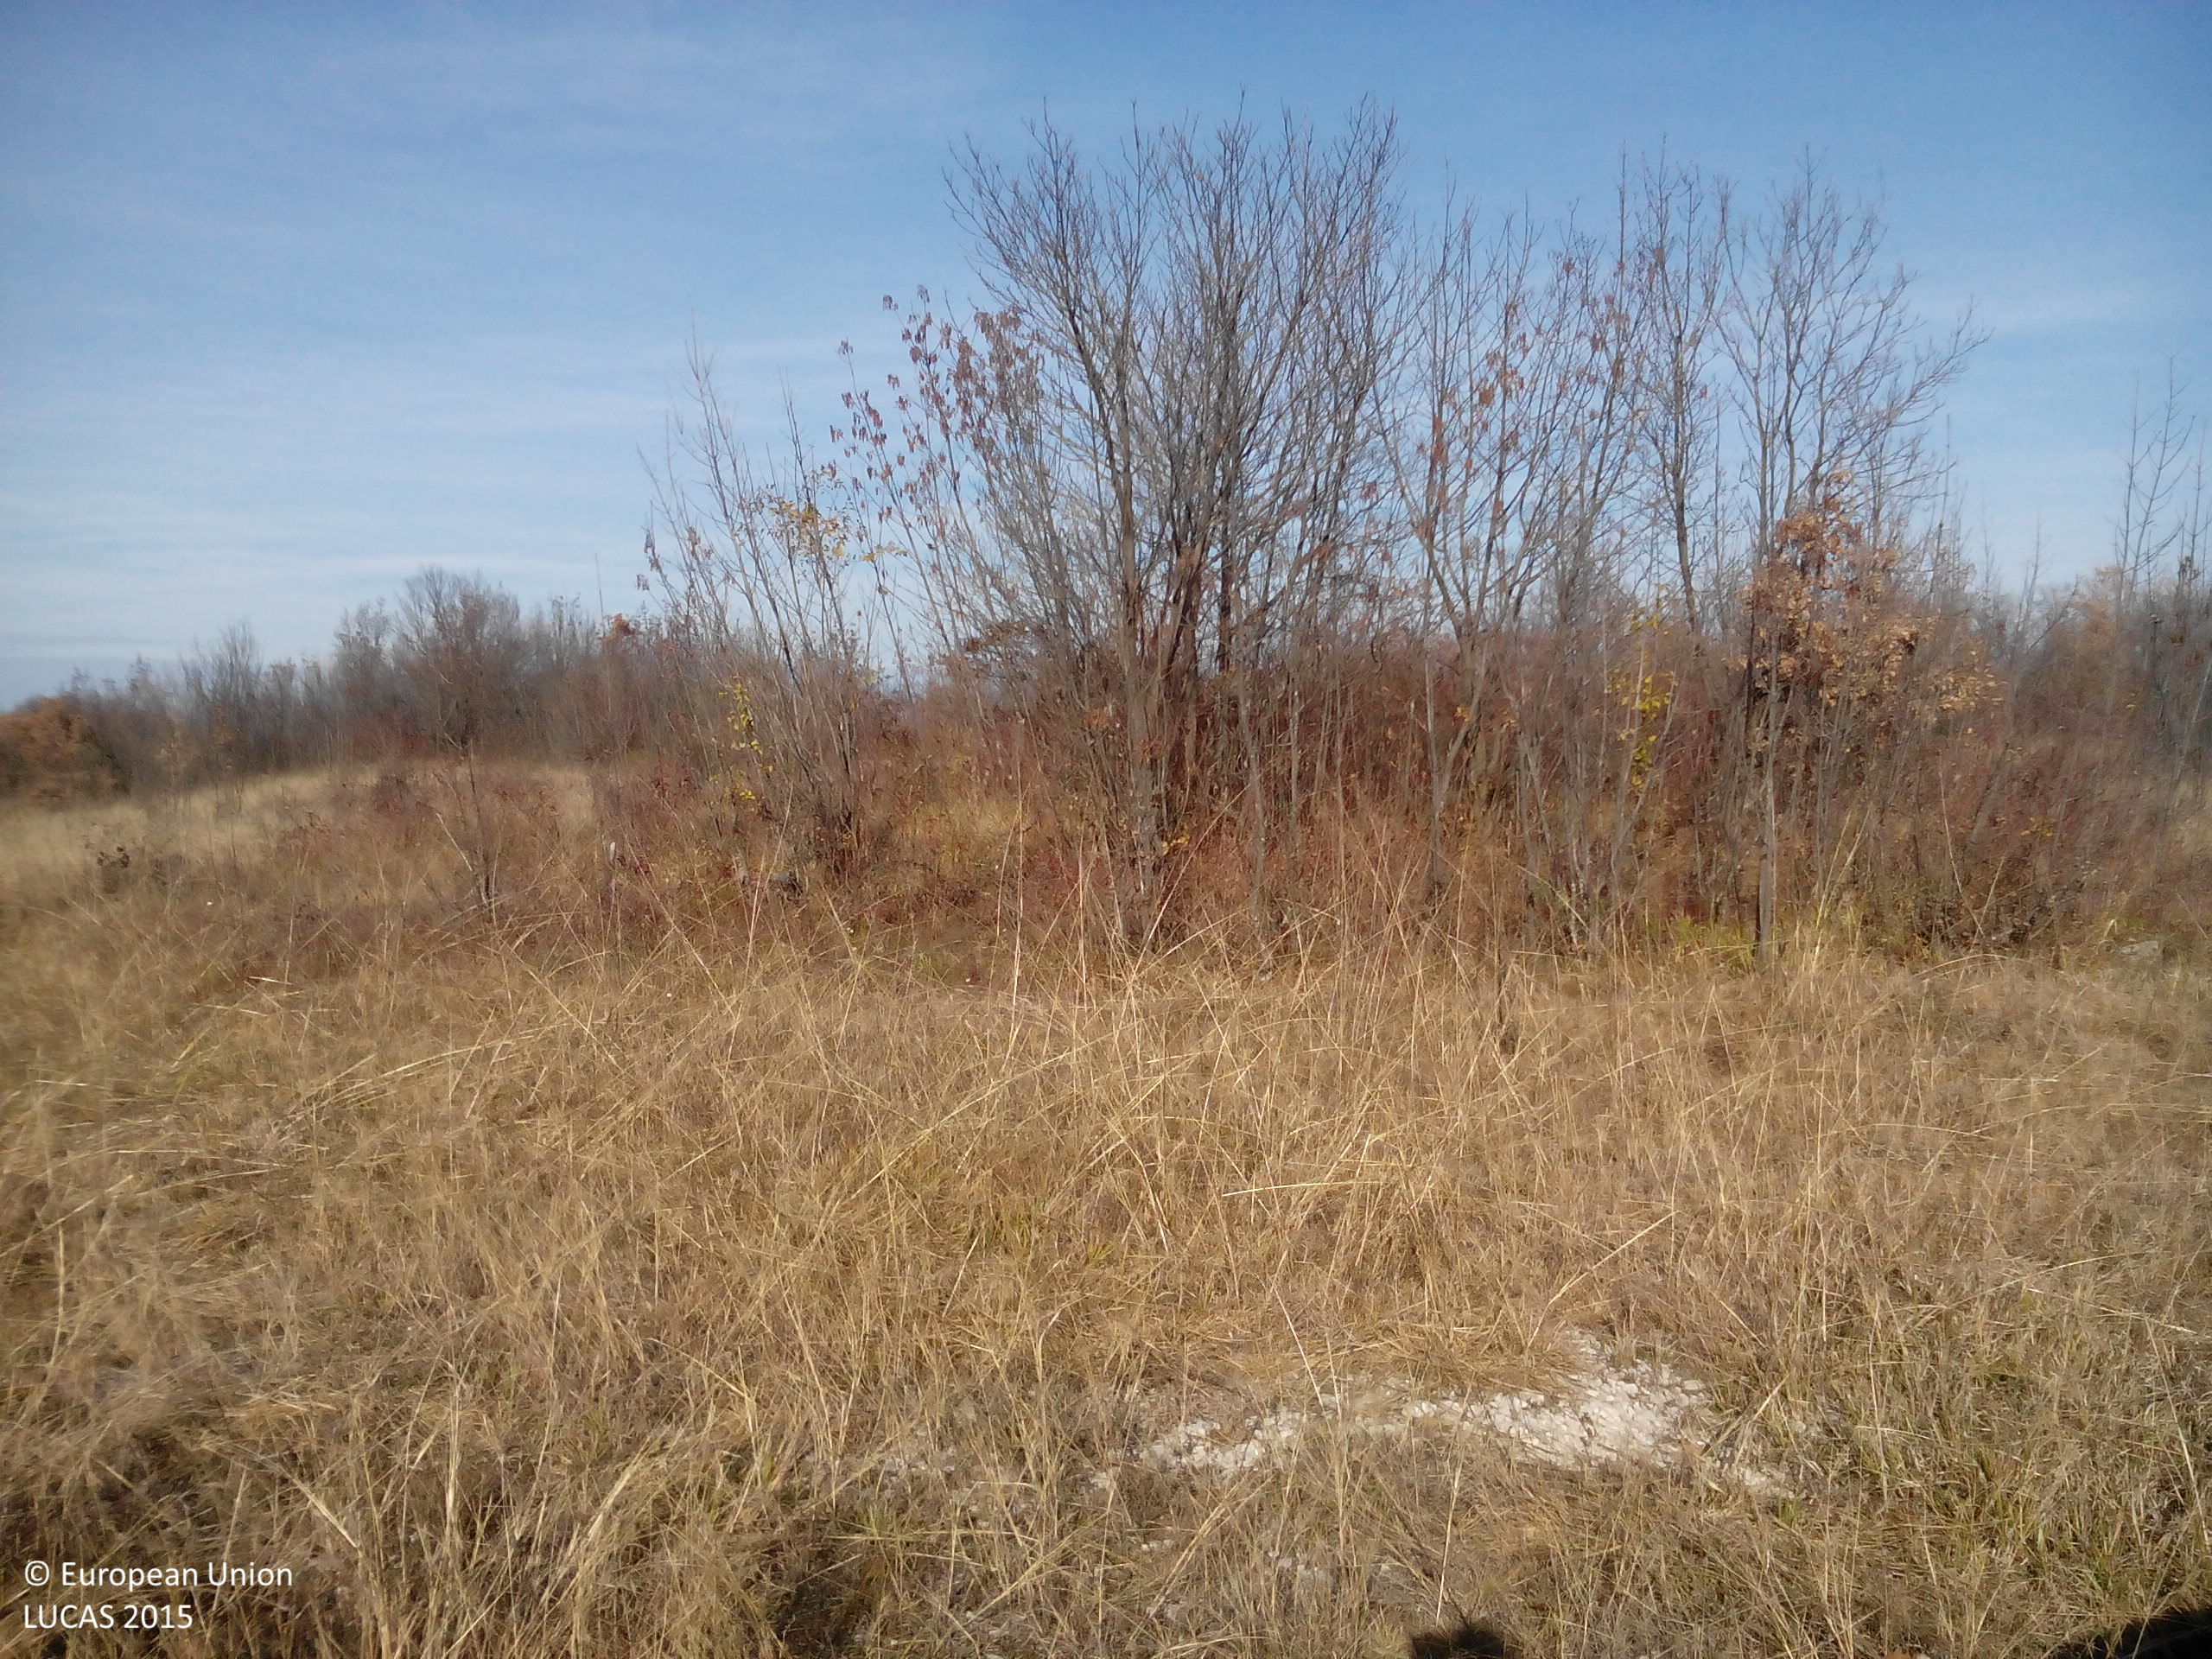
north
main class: Grassland
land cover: Grassland with sparse tree/shrub cover
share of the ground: > 75 %
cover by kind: herbaceous plants 70 %, consolidated bare surface 20 %, broadleaved forest trees 5 %, shrubs 5 %
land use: Telecommunication
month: November
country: BG
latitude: 43.0730
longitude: 23.6880
